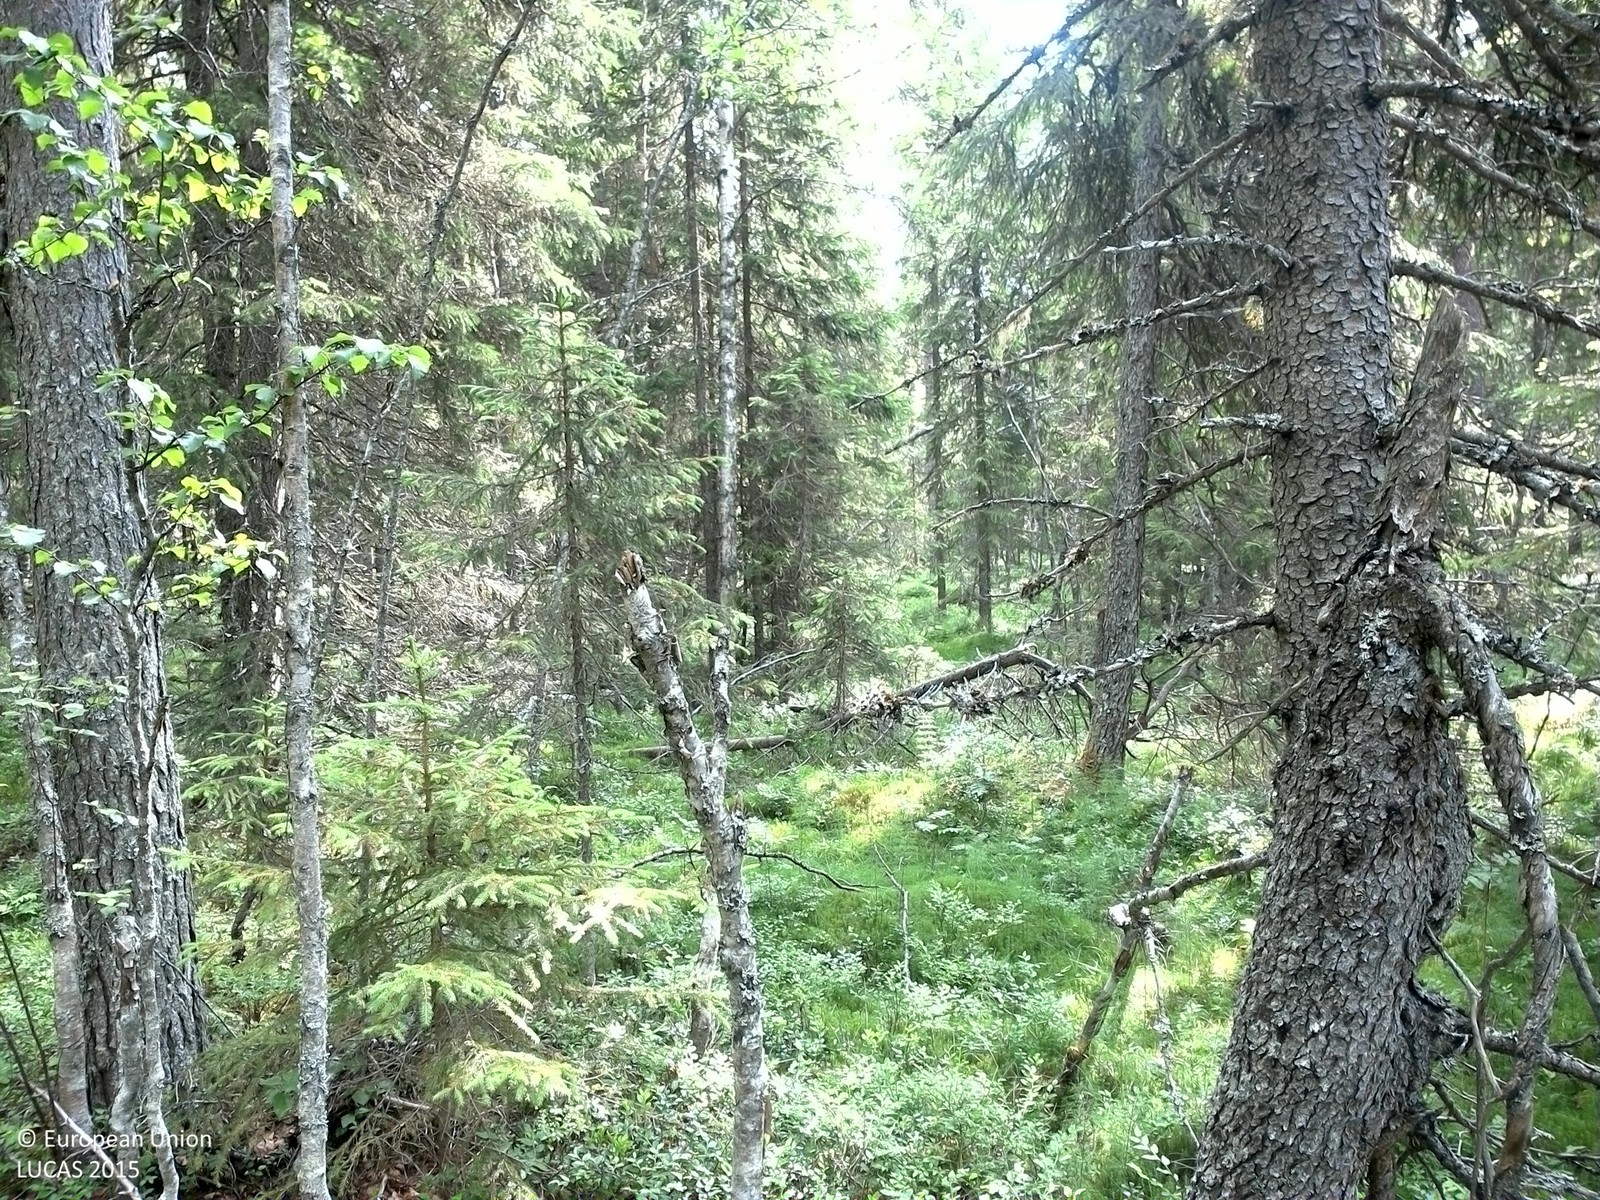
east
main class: Woodland
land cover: Spruce dominated mixed woodland
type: boreal forest
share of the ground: 50 - 75 %
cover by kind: coniferous forest trees 40 %, shrubs 25 %, broadleaved forest trees 15 %, lichens and mosses 15 %, herbaceous plants 5 %
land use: Forestry
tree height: > 5 m
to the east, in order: Spruce dominated mixed woodland; Pine dominated mixed woodland; Spruce dominated mixed woodland; Spruce dominated coniferous woodland
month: July
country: SE
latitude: 63.4787
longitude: 17.4613
